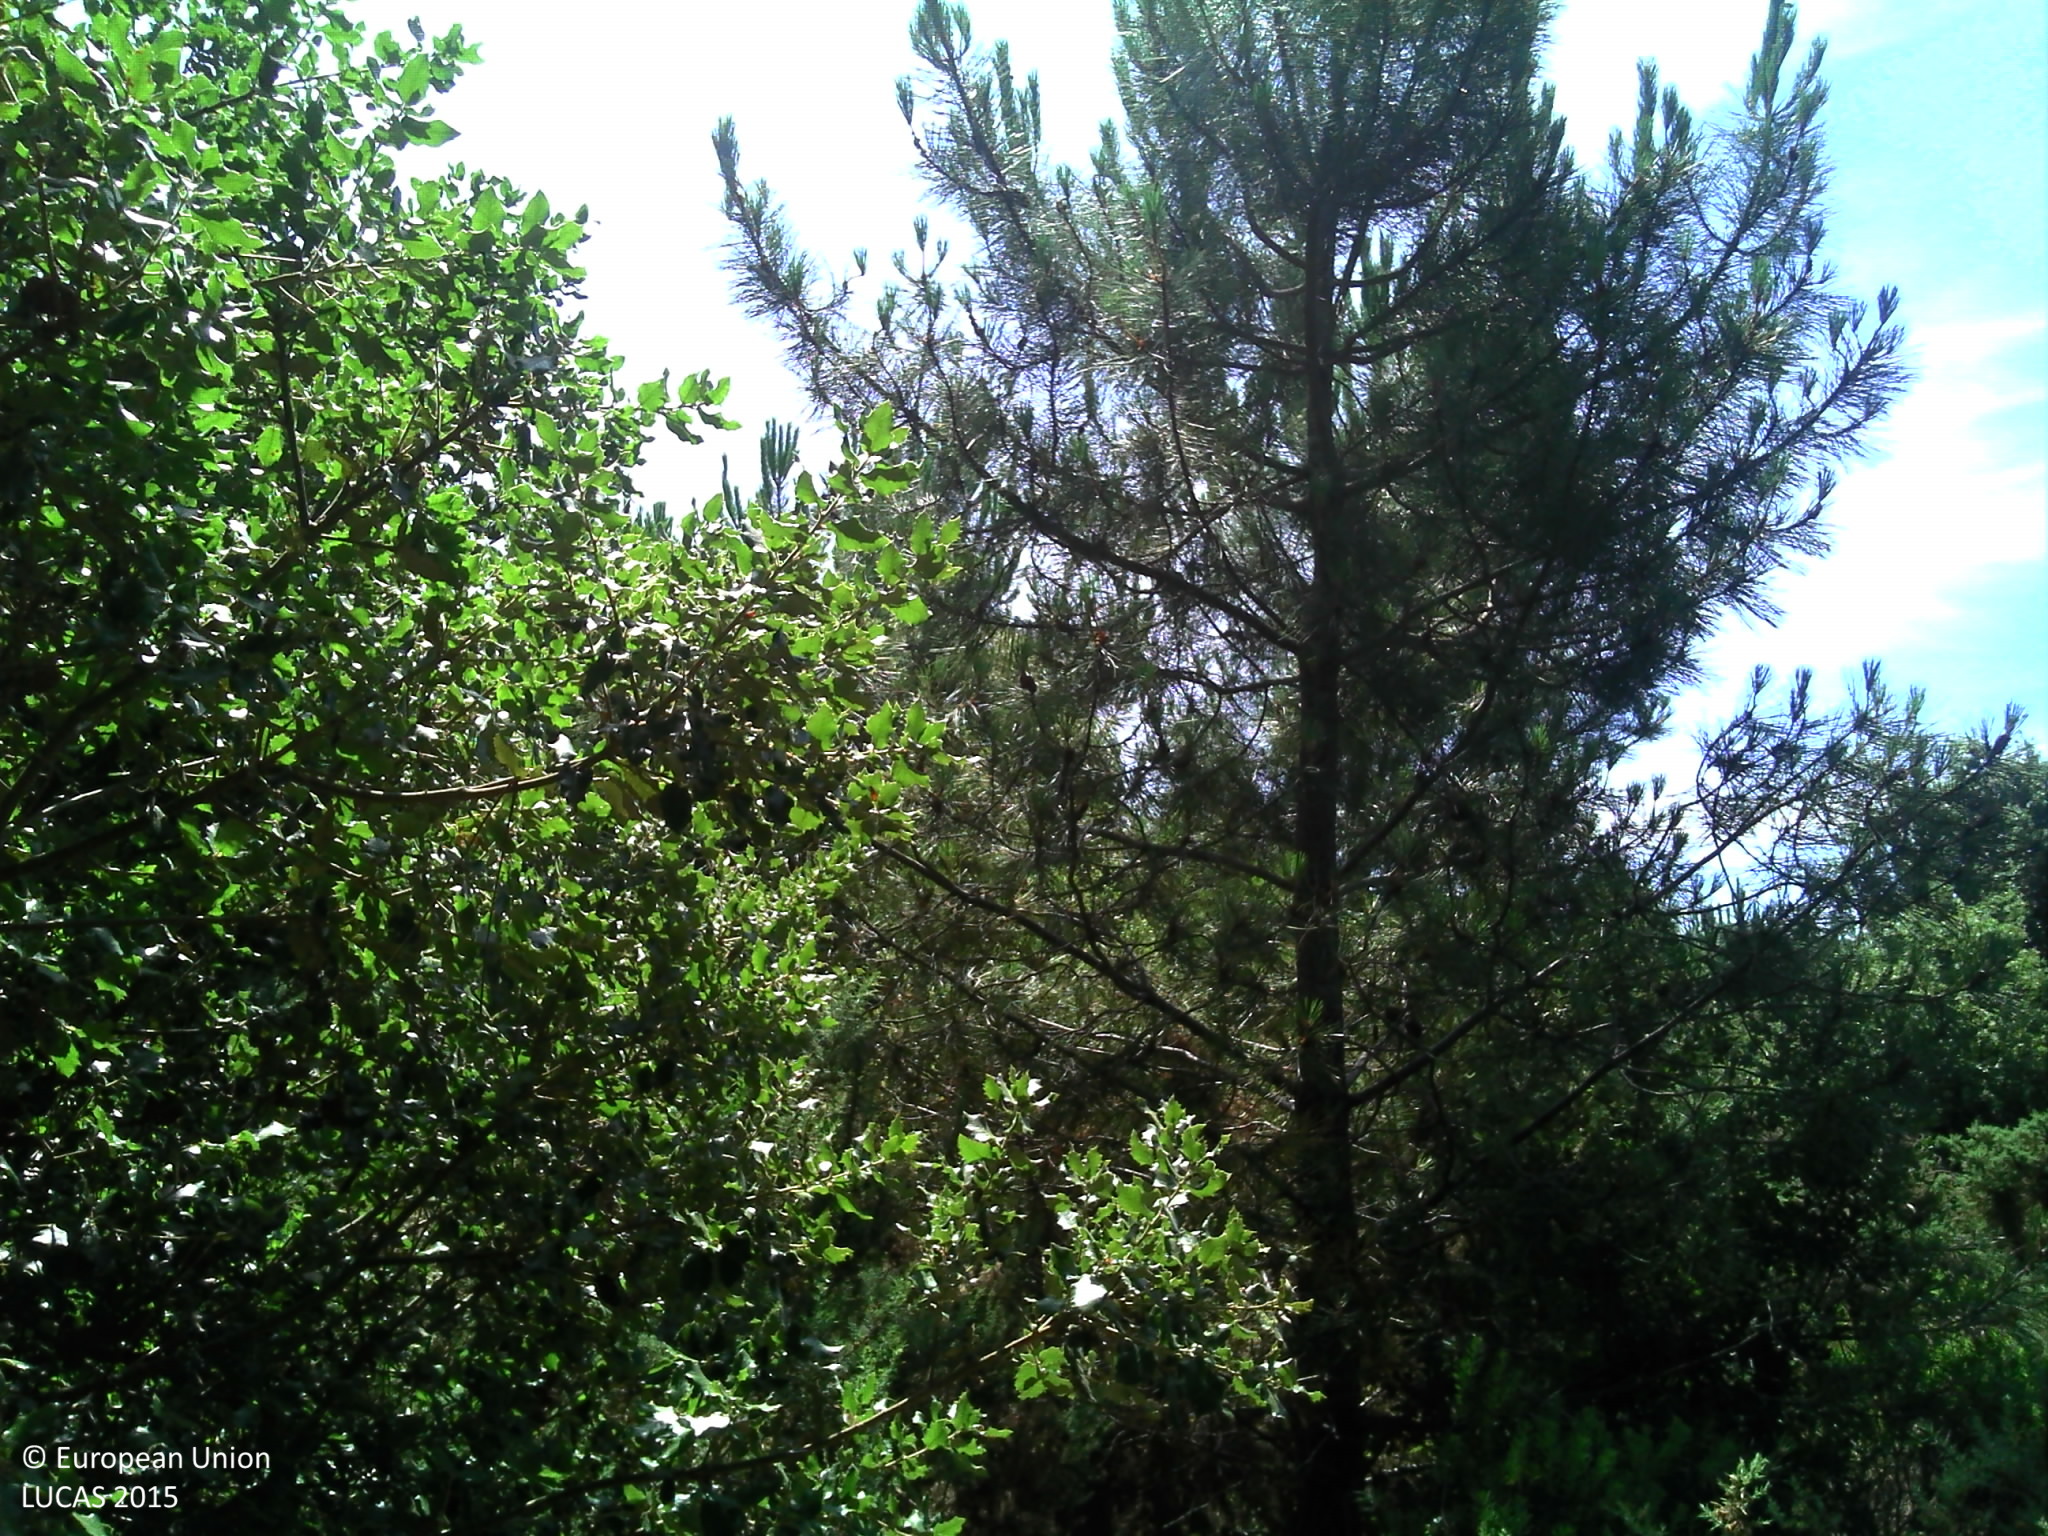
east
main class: Woodland
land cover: Pine dominated mixed woodland
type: broadleaved evergreen forest
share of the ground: > 75 %
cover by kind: coniferous forest trees 75 %, broadleaved forest trees 25 %
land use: Forestry
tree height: > 5 m
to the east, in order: Pine dominated mixed woodland; Tracks; Pine dominated mixed woodland
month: June
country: FR
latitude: 45.7758
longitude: -1.2323
